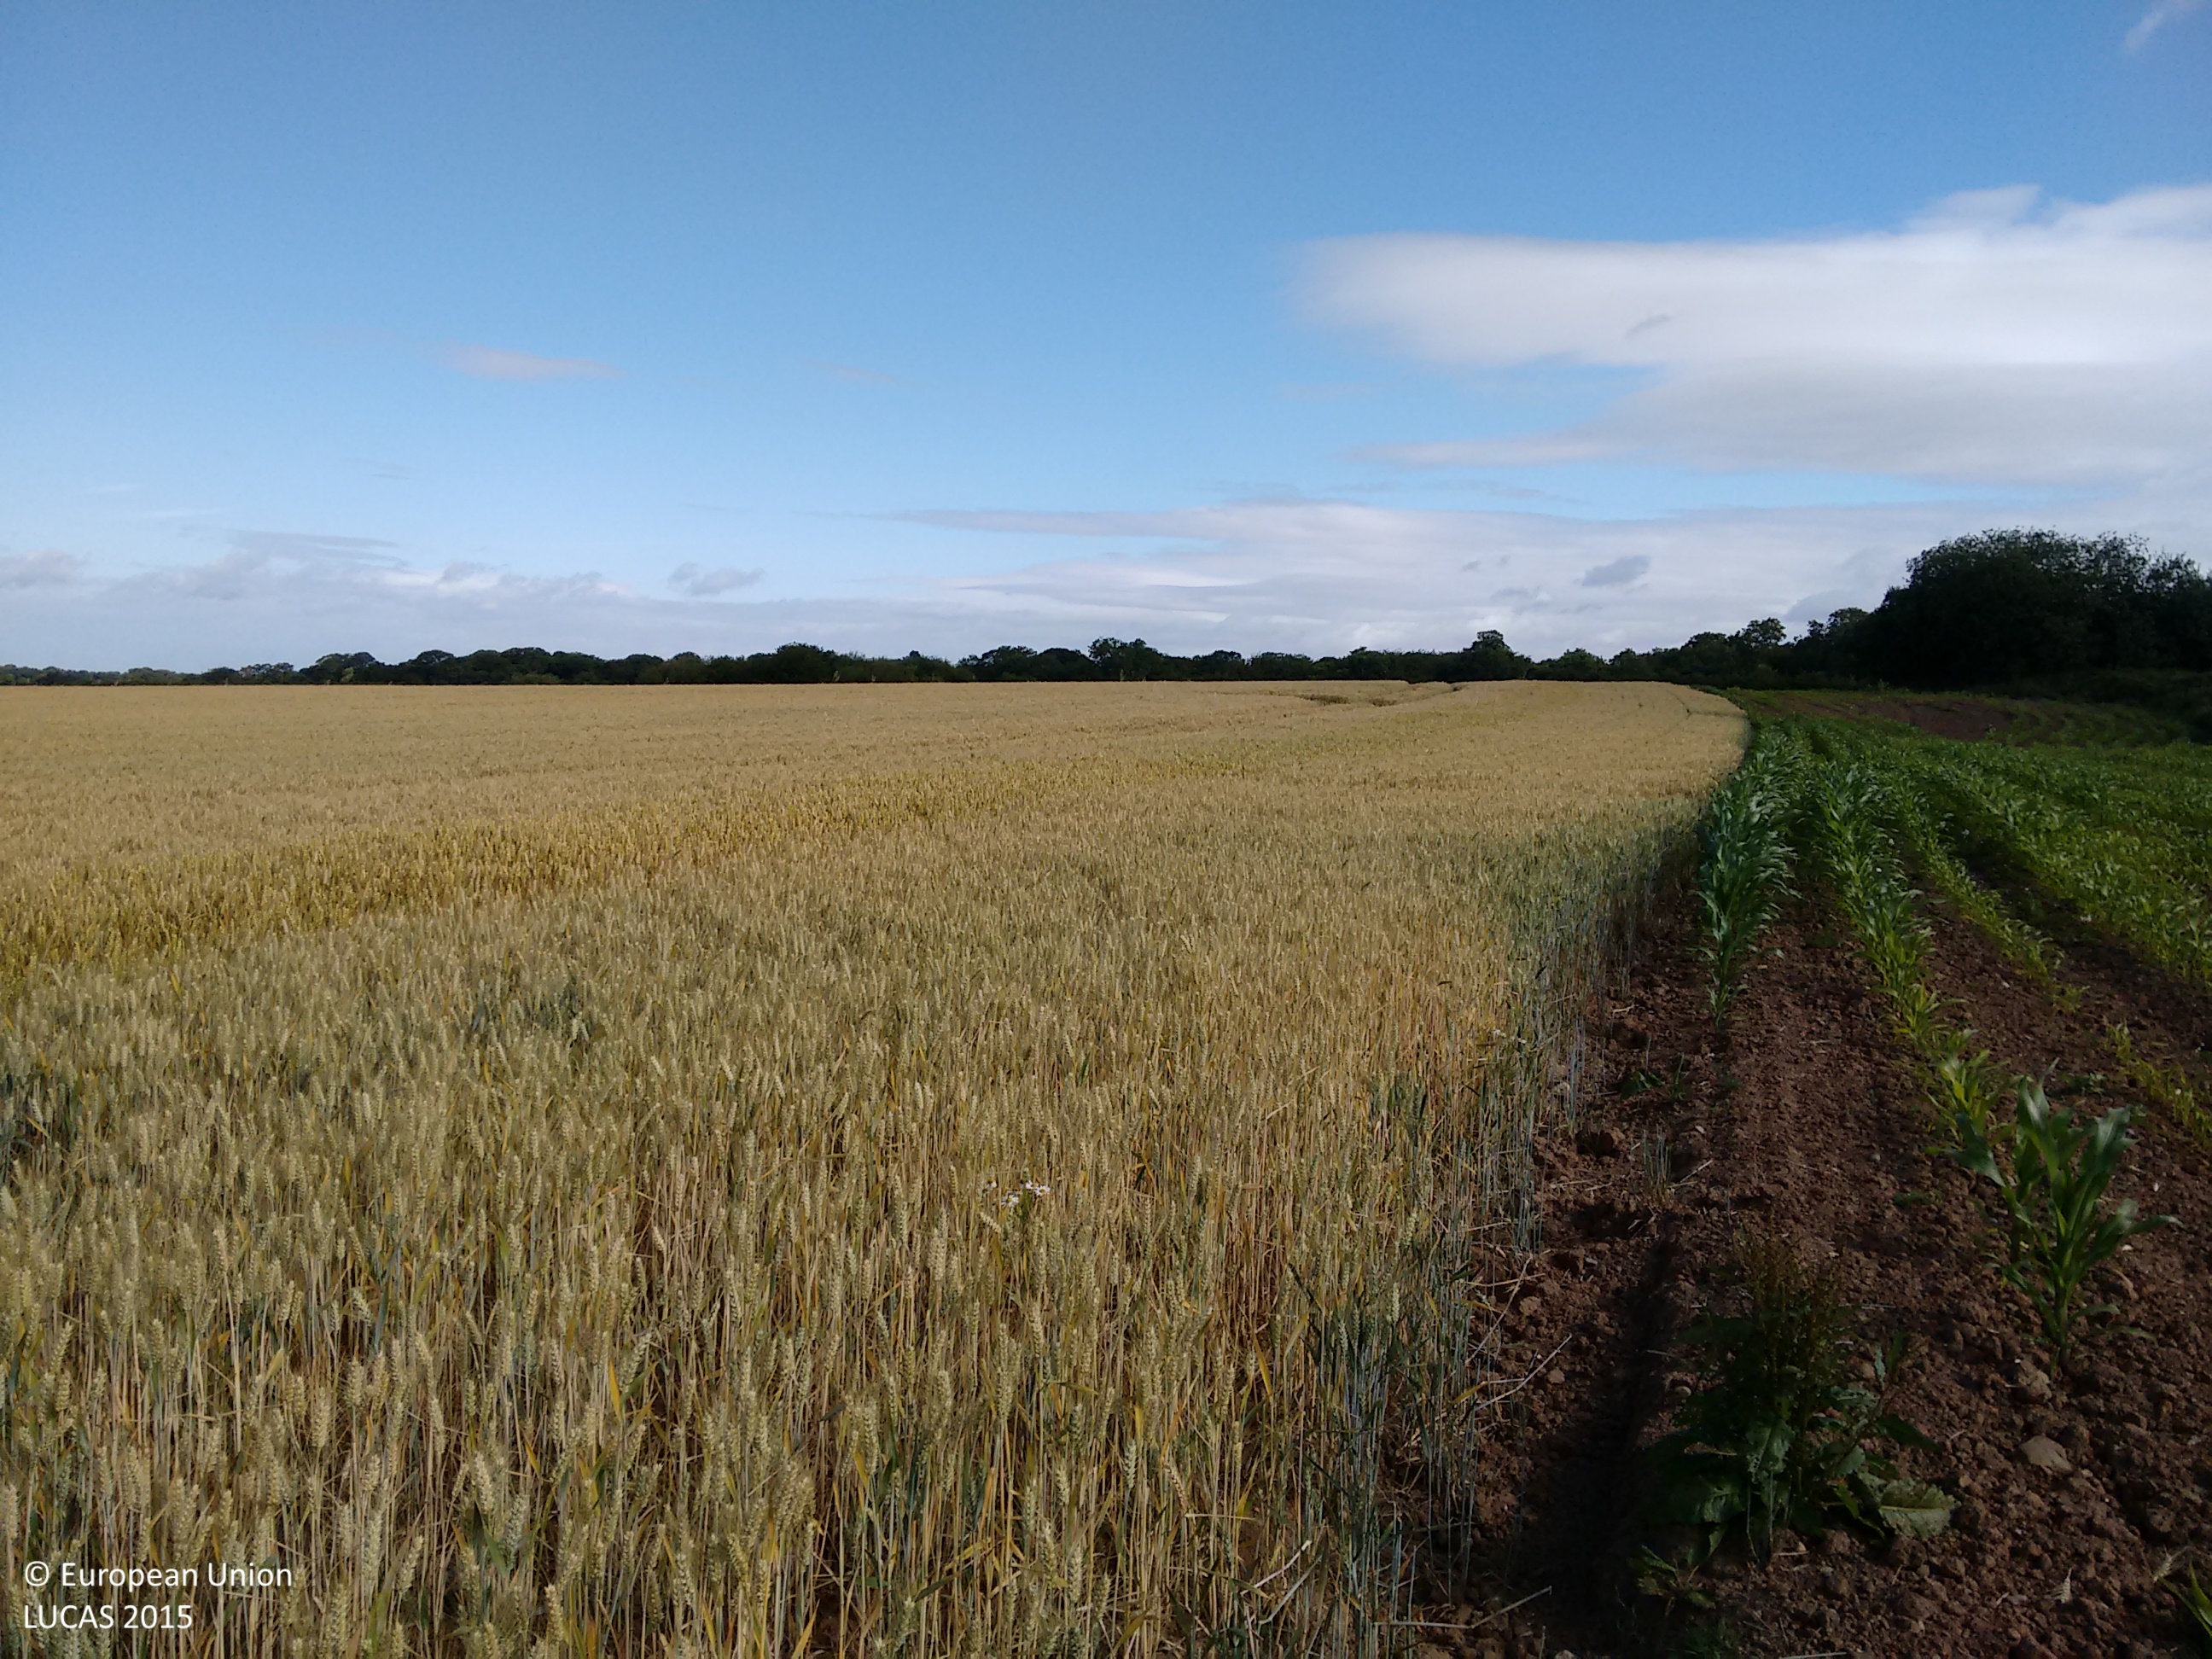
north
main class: Cropland
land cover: Common wheat
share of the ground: > 75 %
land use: Agriculture (excluding fallow land and kitchen gardens)
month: July
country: GB
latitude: 53.2189
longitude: -2.7247
